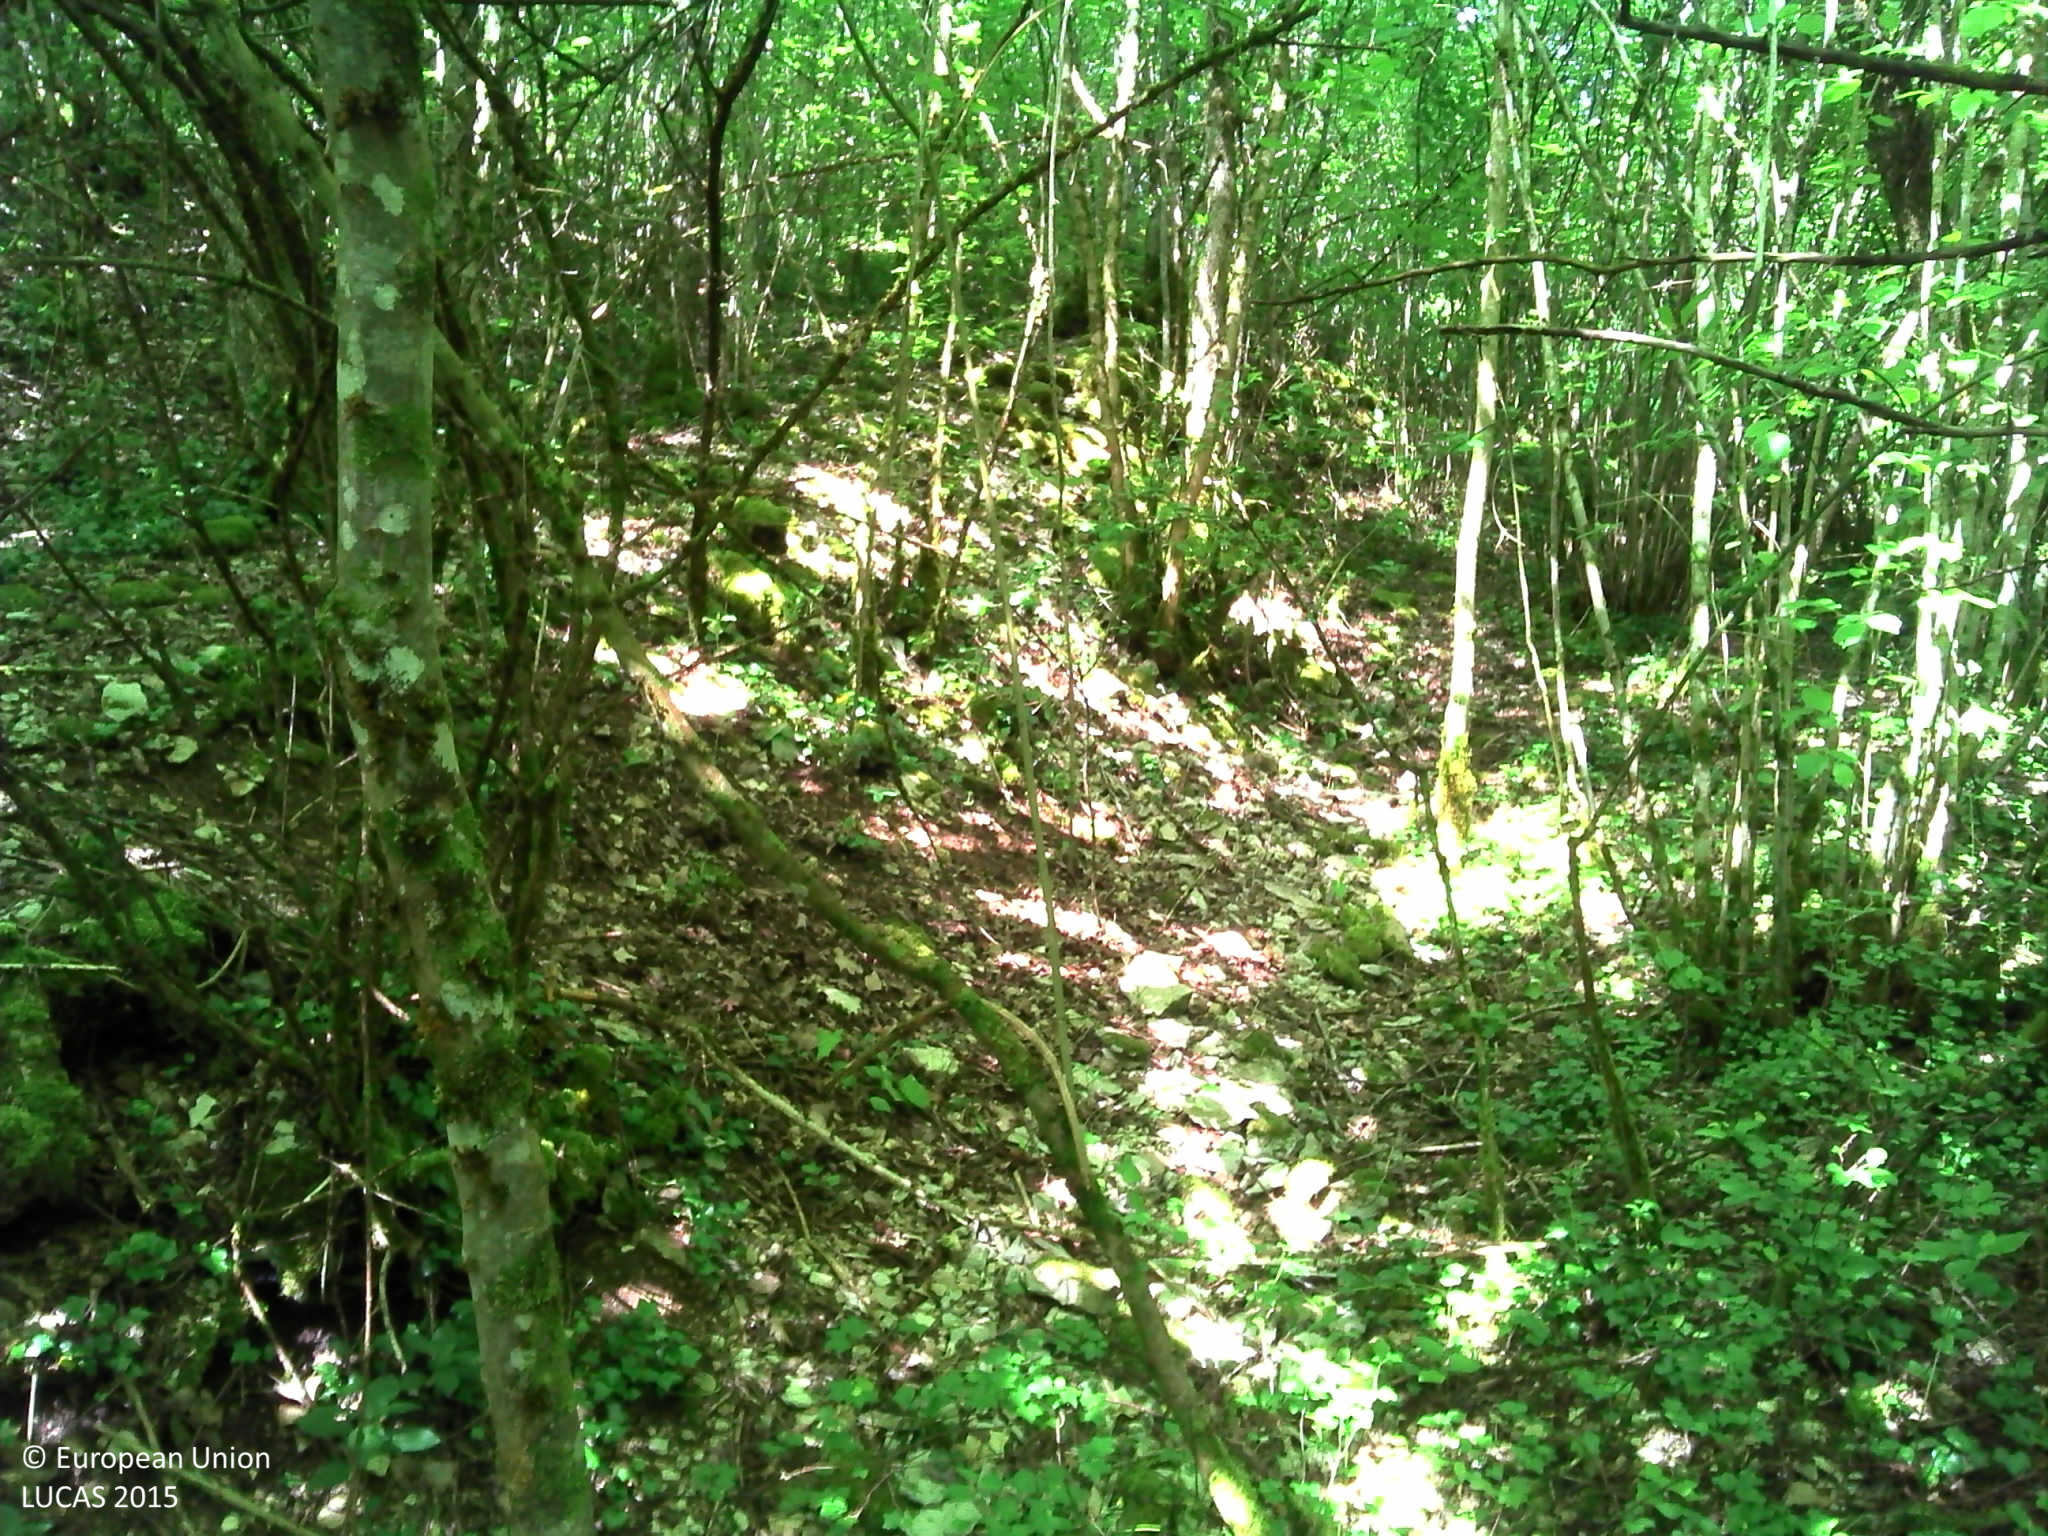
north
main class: Woodland
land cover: Broadleaved woodland
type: mesophytic deciduous forest
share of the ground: > 75 %
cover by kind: broadleaved forest trees 95 %, herbaceous plants 5 %
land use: Forestry
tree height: > 5 m
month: May
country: FR
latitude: 47.5005
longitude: 5.0751
